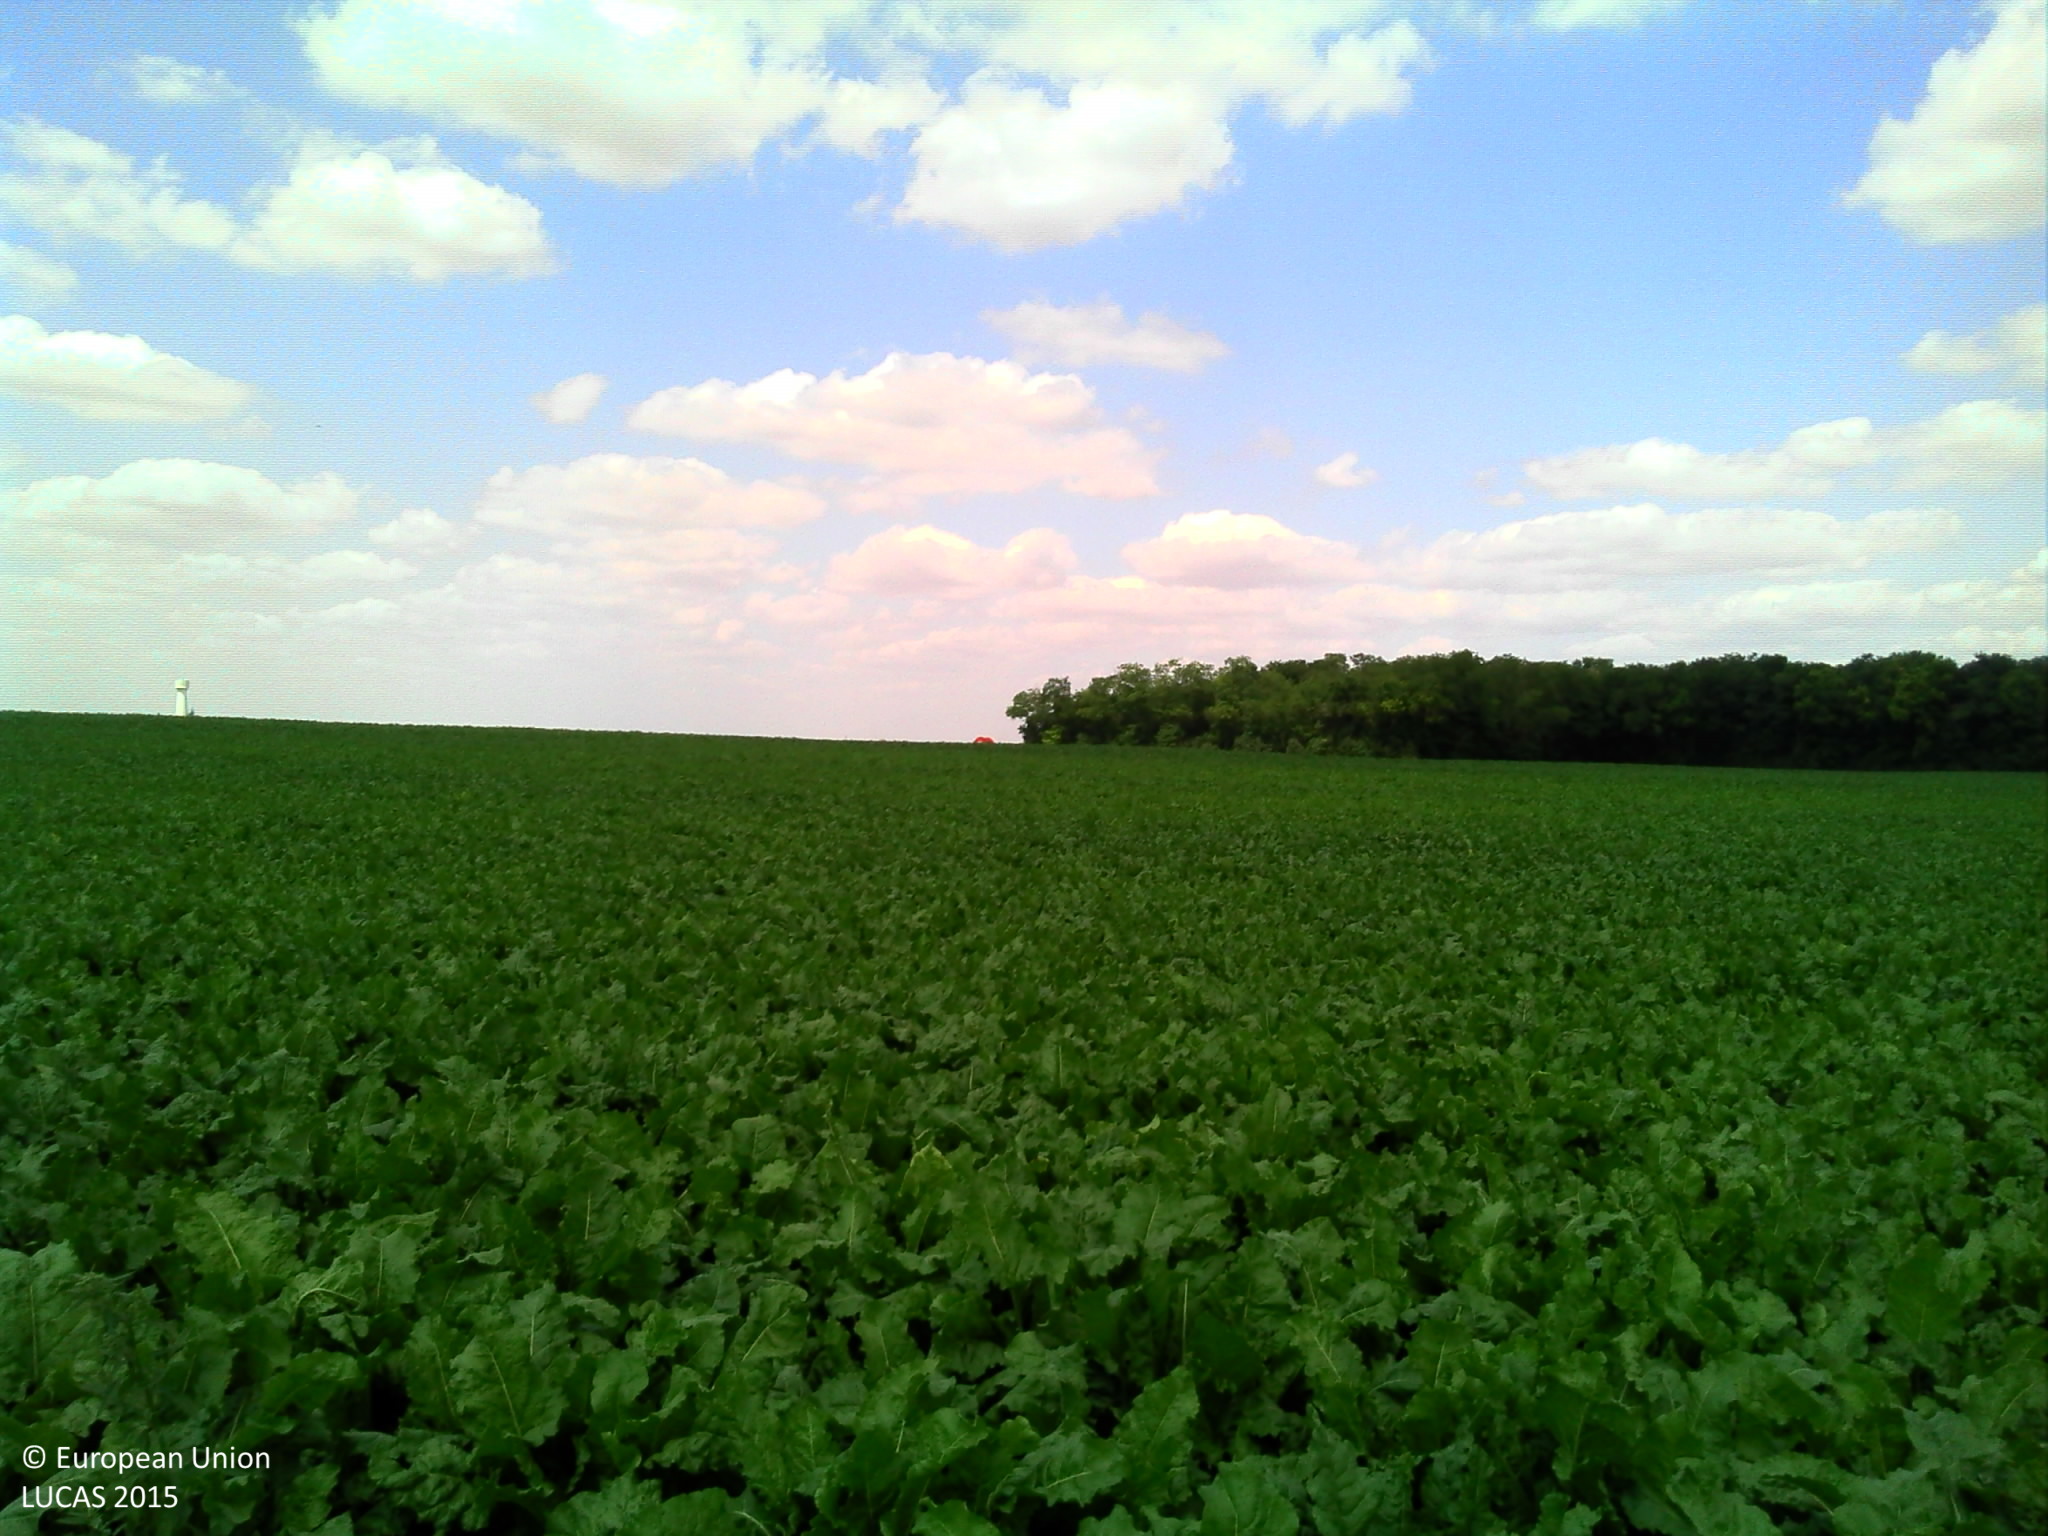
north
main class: Cropland
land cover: Sugar beet
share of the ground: > 75 %
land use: Agriculture (excluding fallow land and kitchen gardens)
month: July
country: FR
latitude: 48.0575
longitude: 2.4900
